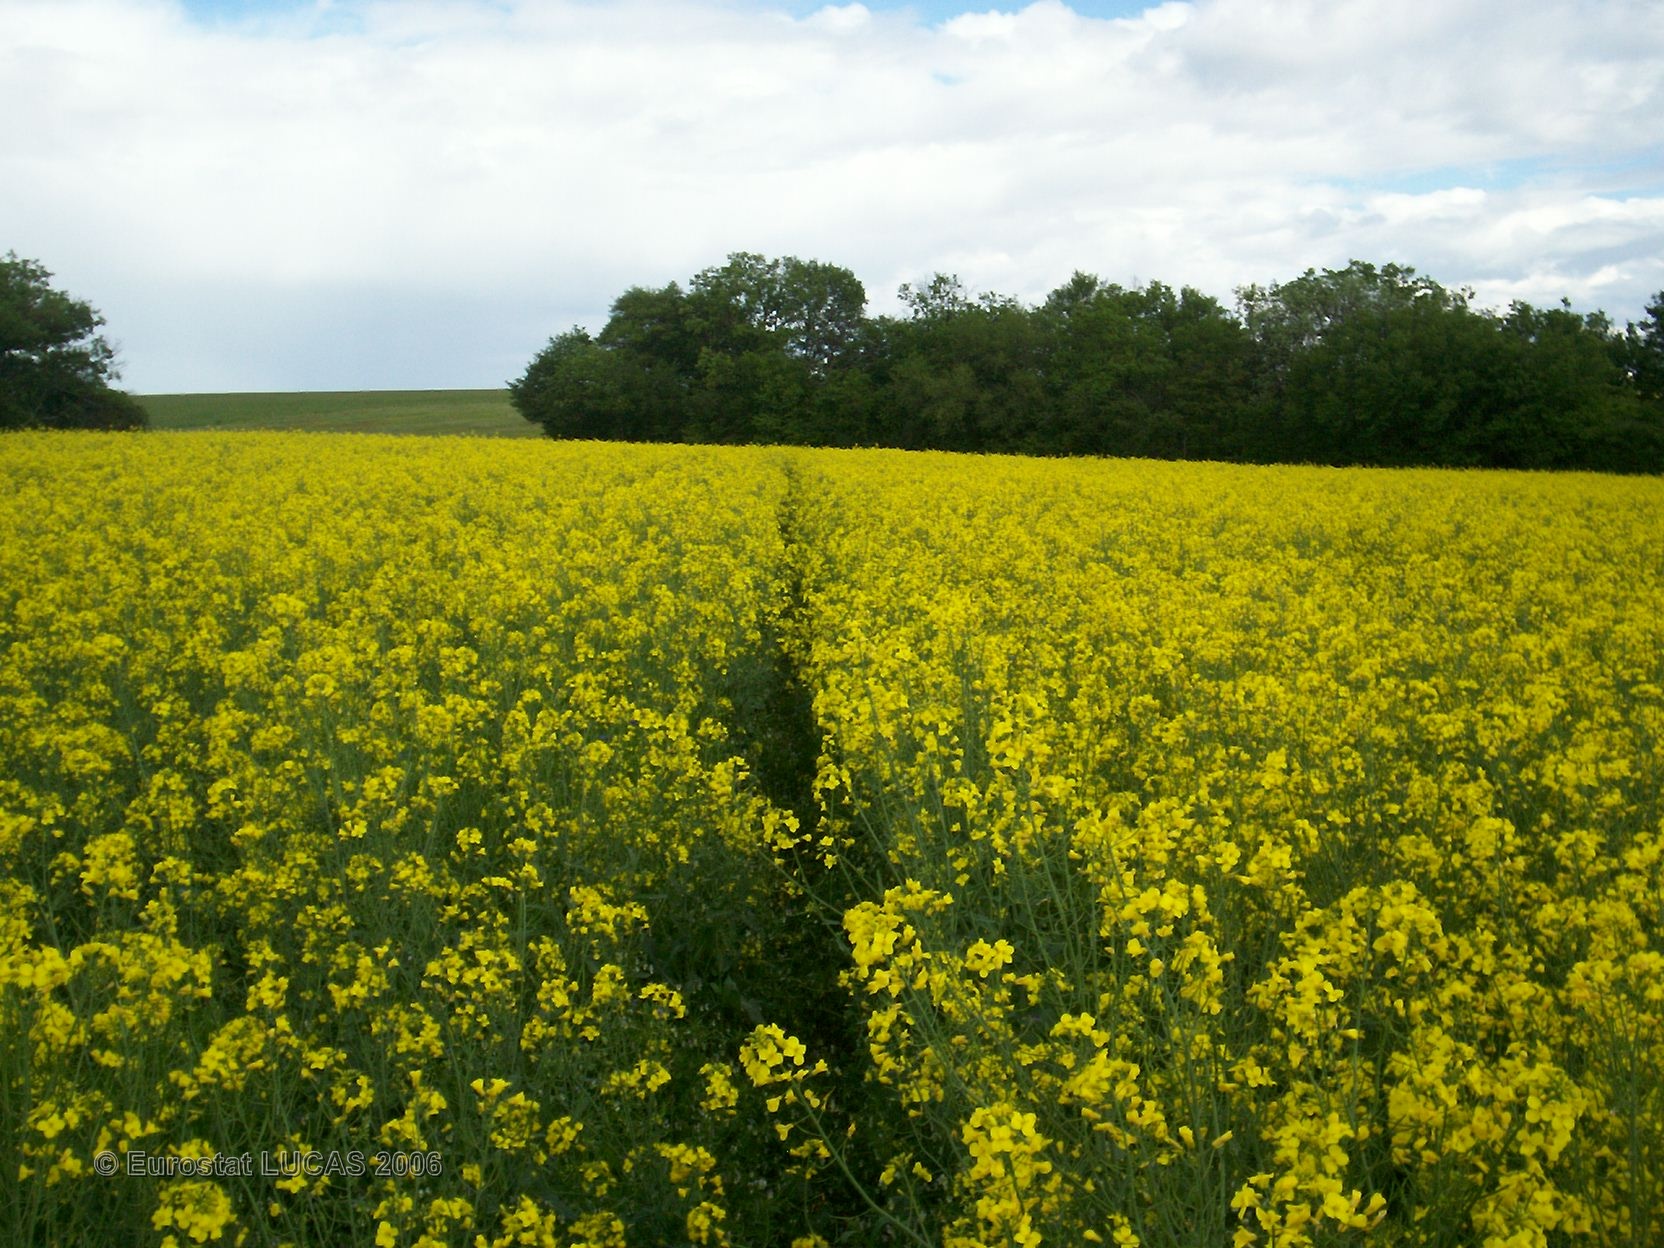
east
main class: Cropland
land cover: Rape and turnip rape
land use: Agriculture (excluding fallow land and kitchen gardens)
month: May
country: FR
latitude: 46.9933
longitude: 4.6486
